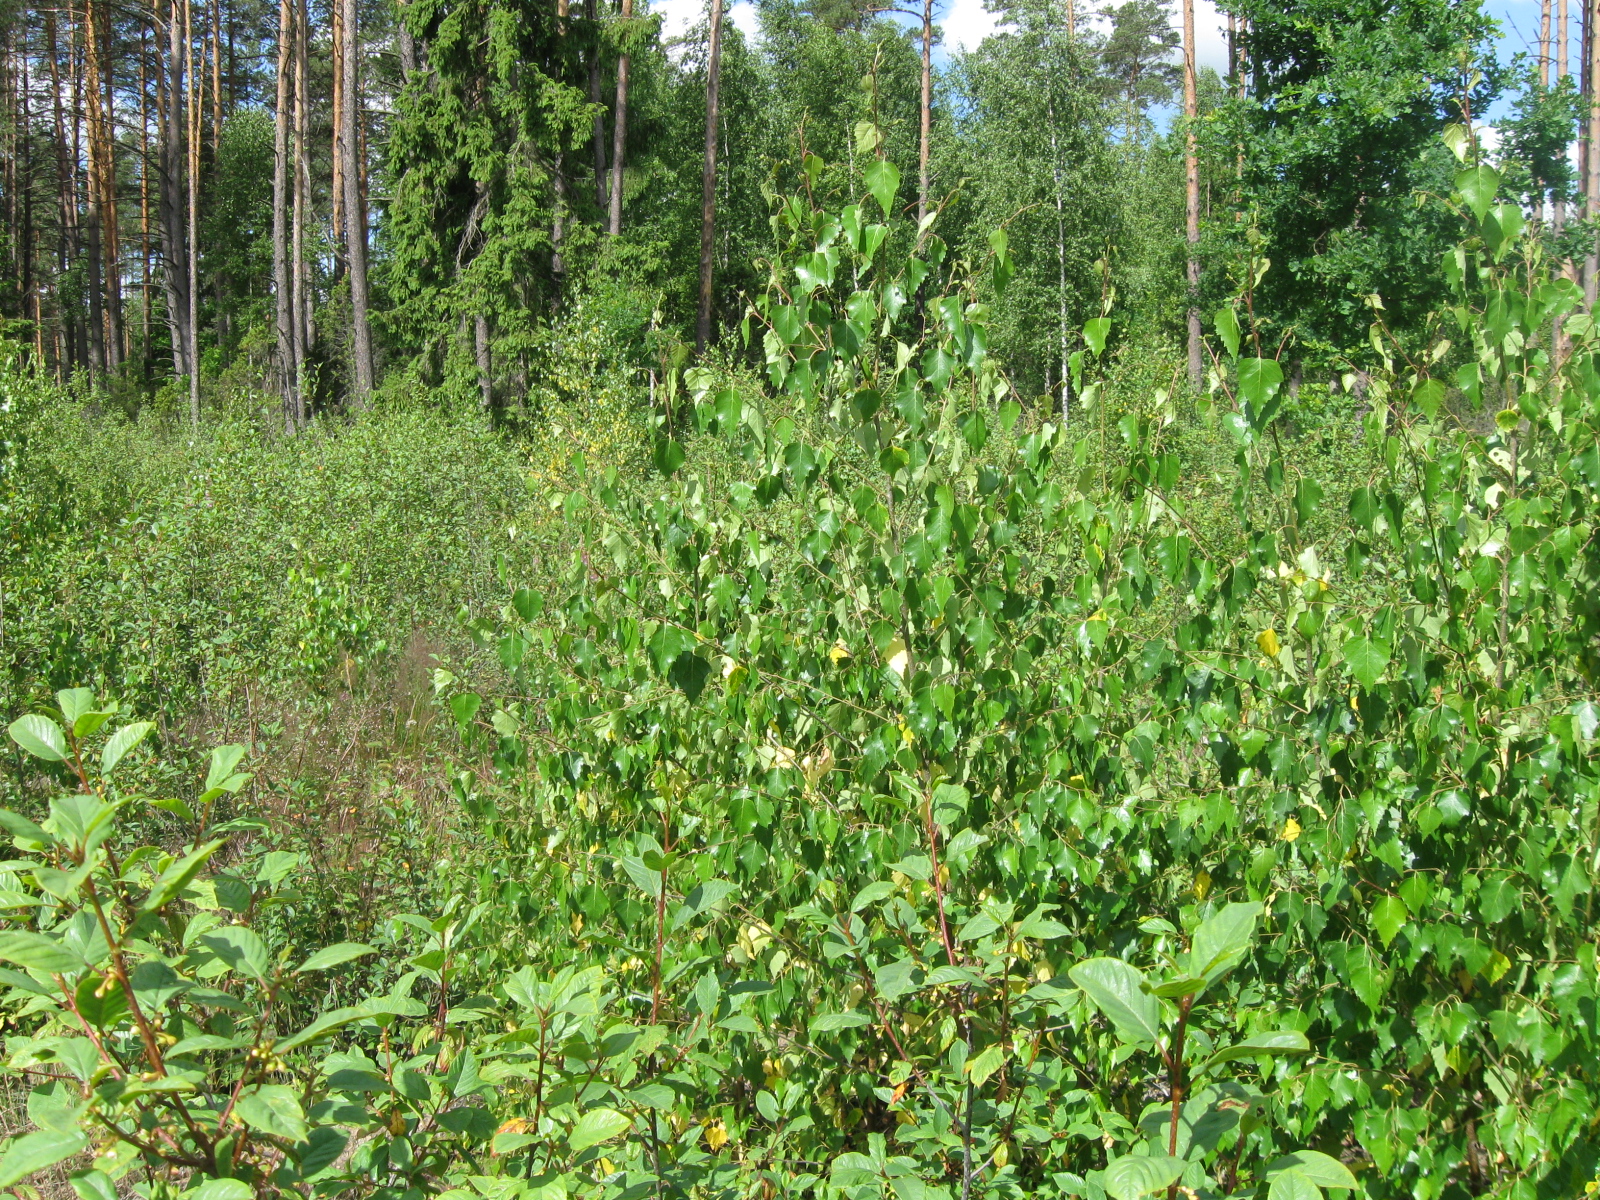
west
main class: Woodland
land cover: Broadleaved woodland
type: non-riverine alder, birch or aspen forest
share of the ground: 50 - 75 %
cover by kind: broadleaved forest trees 65 %, shrubs 15 %, herbaceous plants 15 %, unconsolidated bare surface 5 %
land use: Forestry
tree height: < 5 m
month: July
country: LT
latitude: 54.3281
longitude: 24.5433
